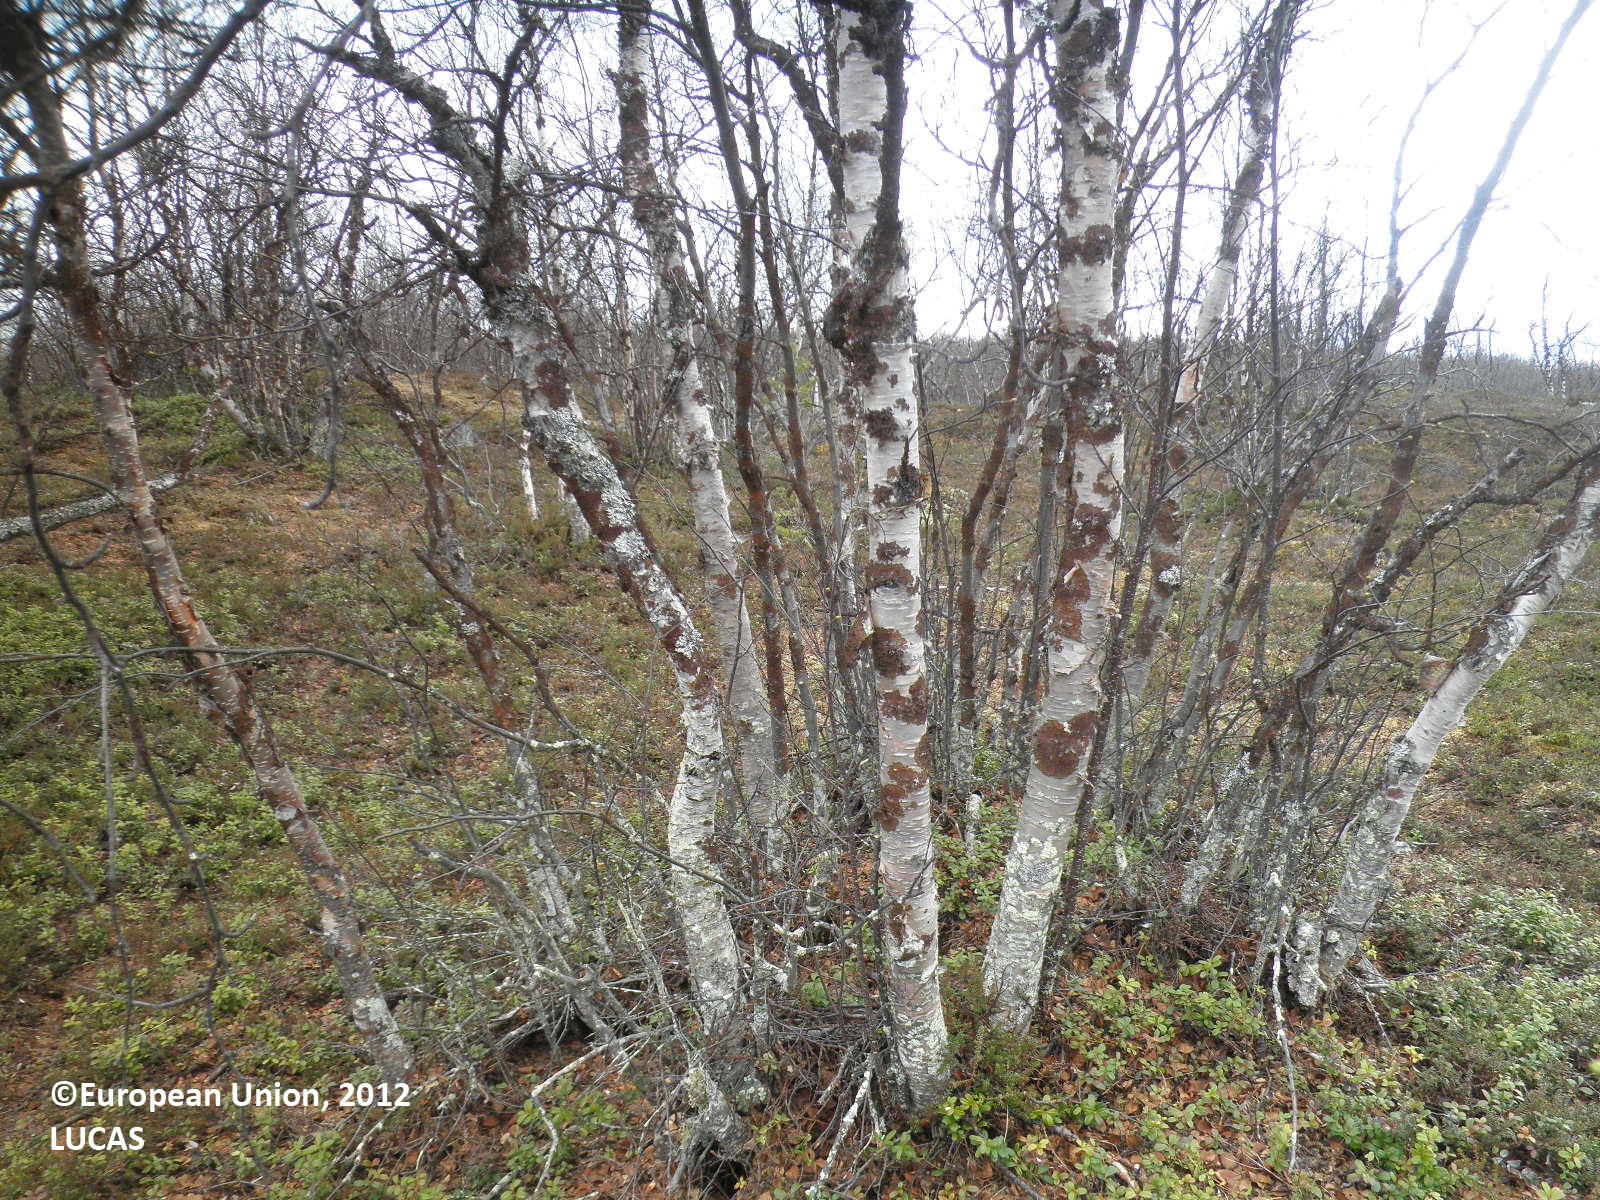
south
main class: Woodland
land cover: Broadleaved woodland
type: boreal forest
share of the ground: 50 - 75 %
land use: Forestry
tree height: > 5 m
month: May
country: FI
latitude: 69.1819
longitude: 26.9192
